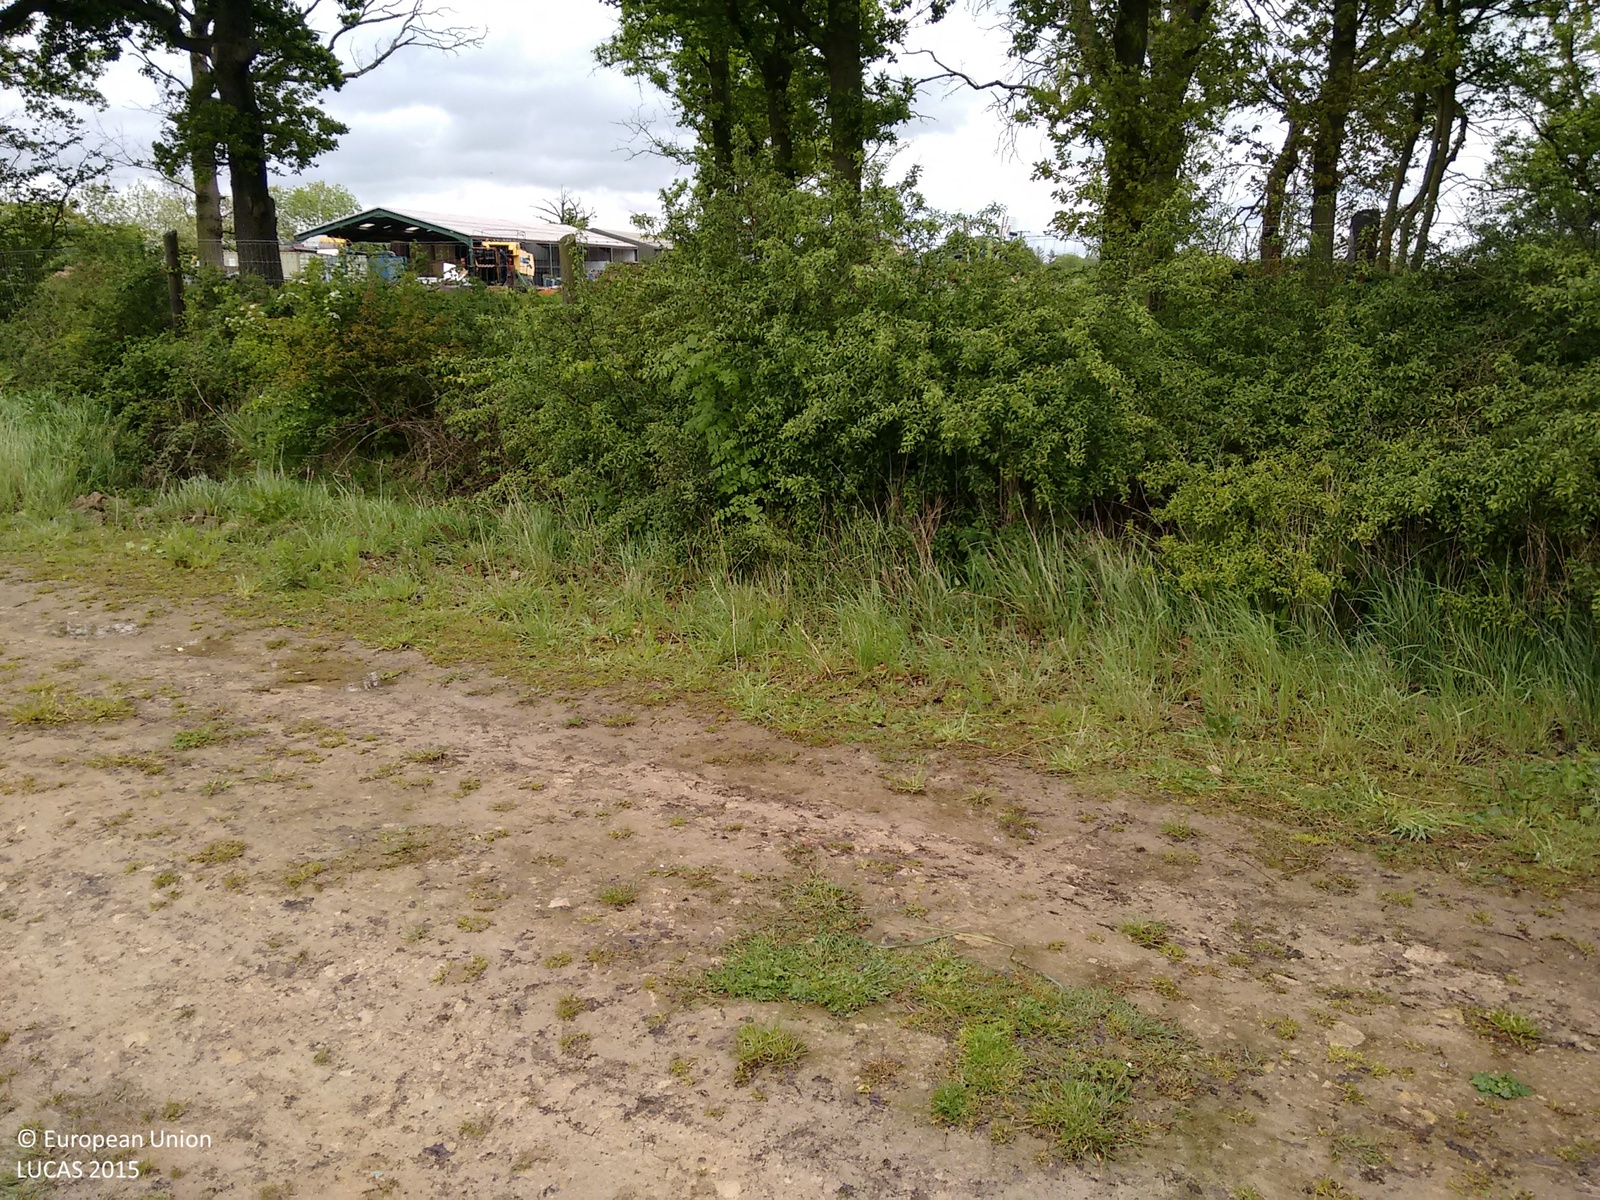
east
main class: Grassland
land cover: Grassland without tree/shrub cover
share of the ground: > 75 %
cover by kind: herbaceous plants 100 %
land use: Agriculture (excluding fallow land and kitchen gardens)
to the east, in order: Grassland without tree/shrub cover; Tracks; Grass margins; Ditches and canals; Fences; Broadleaved woodland; Artificial constructions in urban areas; Grassland without tree/shrub cover; Fences; Grassland without tree/shrub cover; Inland fresh water bodies; Grassland without tree/shrub cover; Fences; Paved roads, cycling and walking lanes; Grassland without tree/shrub cover; Electric lines; Grassland without tree/shrub cover; Paved roads, cycling and walking lanes; Single bushes/trees; Paved roads, cycling and walking lanes; Grassland without tree/shrub cover
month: May
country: GB
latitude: 53.6138
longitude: -1.1249
